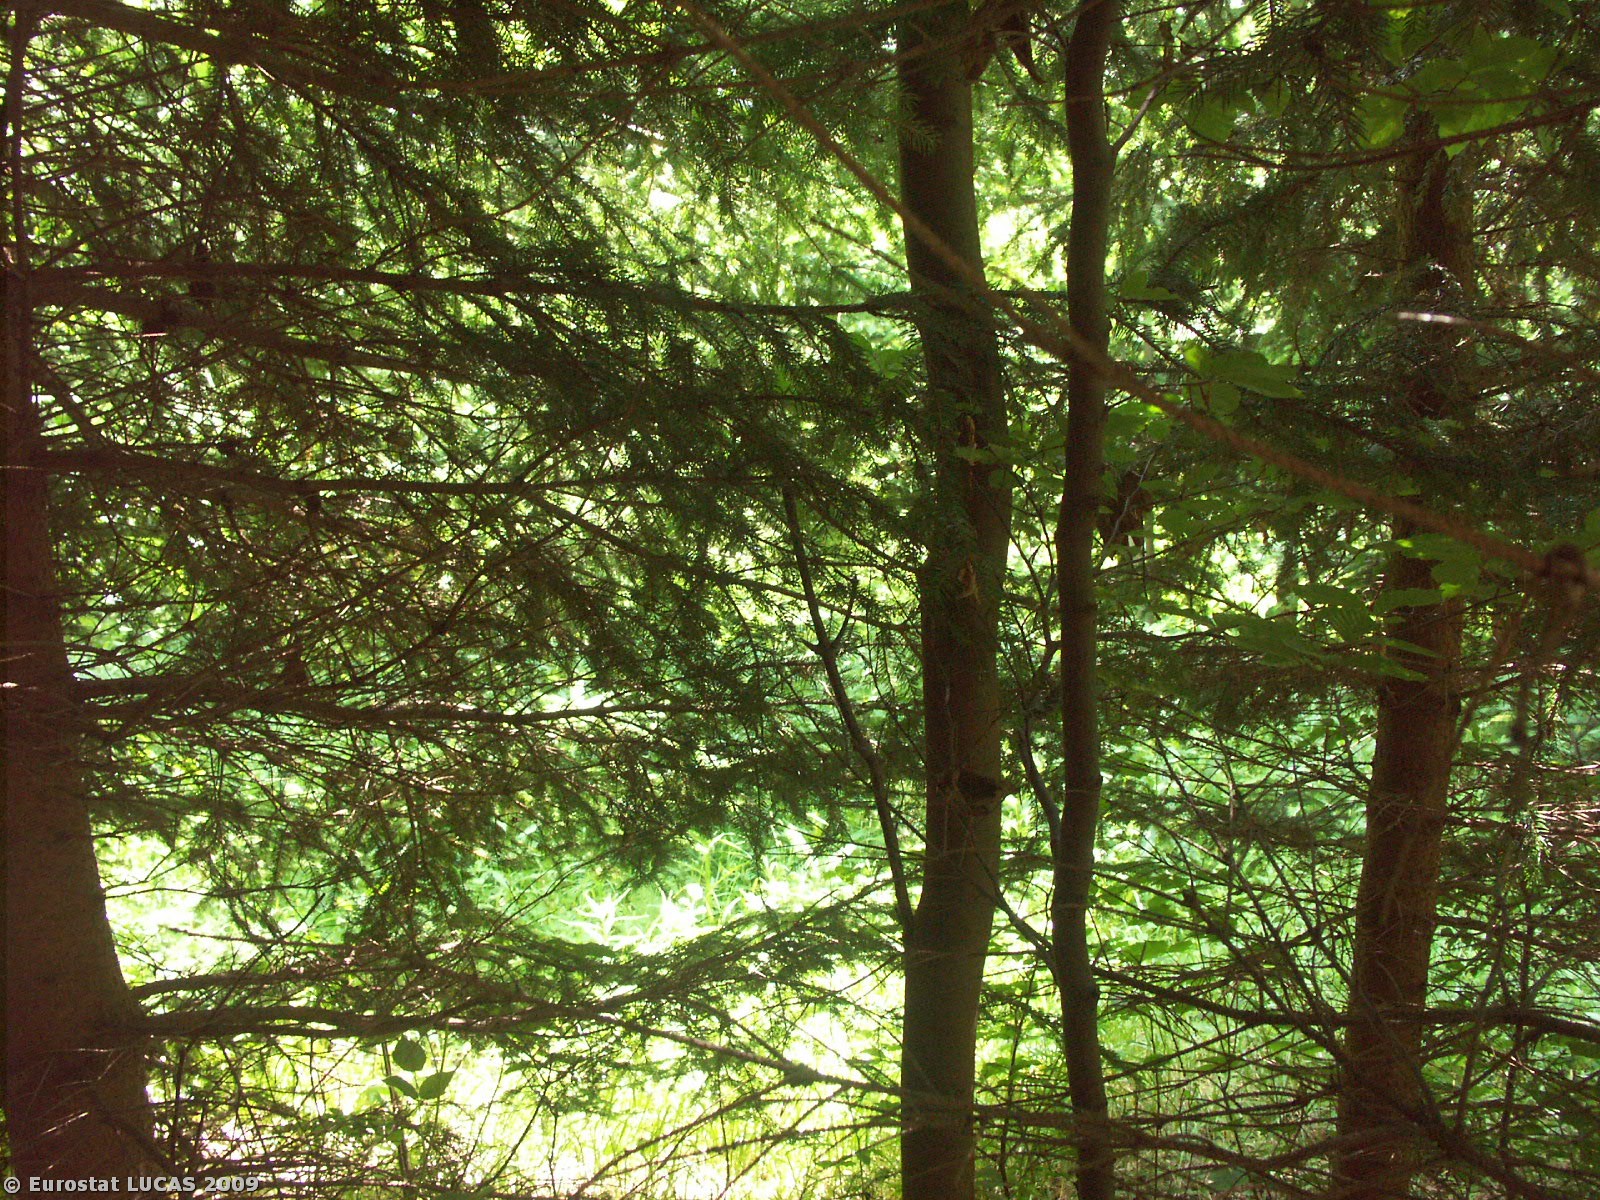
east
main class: Woodland
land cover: Mixed woodland
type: hemiboreal forest and nemoral coniferous forest and mixed broadleaved-coniferous forest
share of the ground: > 75 %
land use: Forestry
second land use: Nature reserves
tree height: > 5 m
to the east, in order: Mixed woodland; Tracks; Mixed woodland; Tracks; Mixed woodland; Rivers and streams; Mixed woodland
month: July
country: CZ
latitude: 50.0037
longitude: 17.3084
